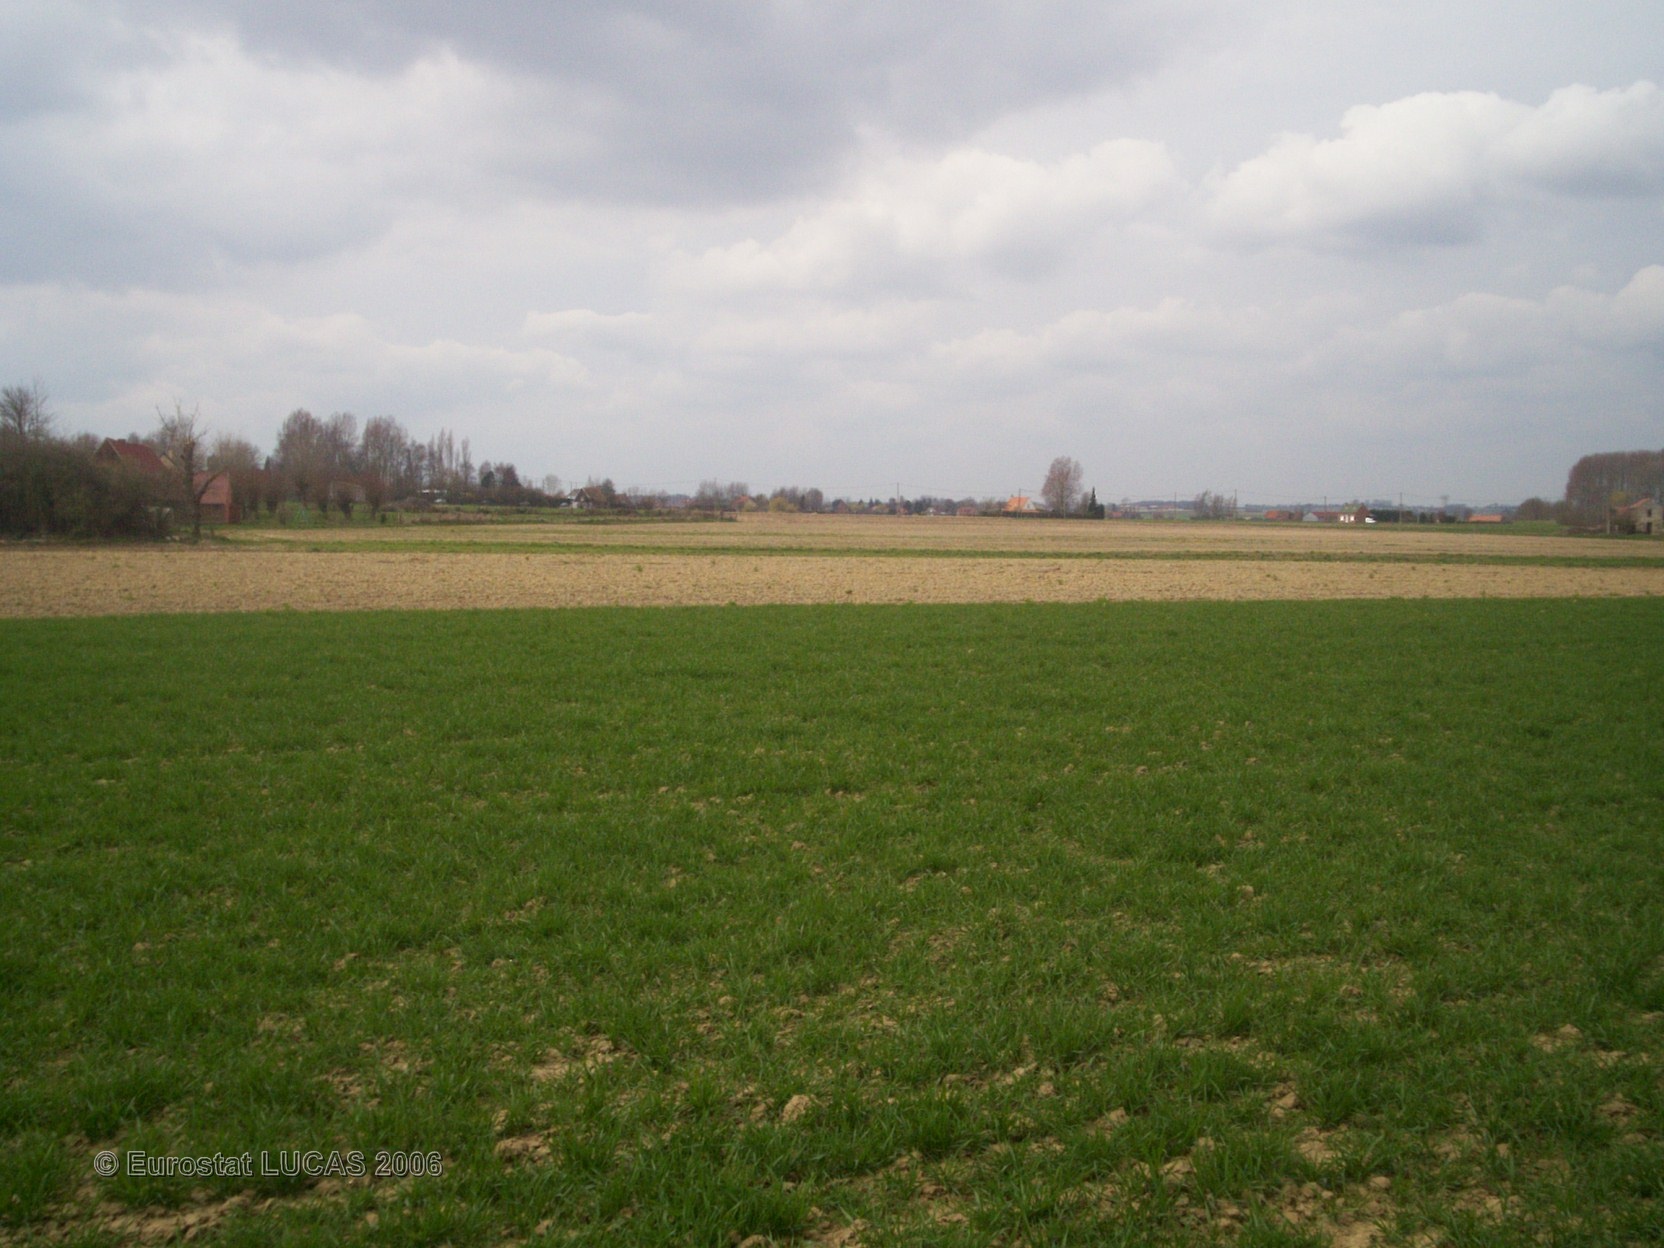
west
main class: Cropland
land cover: Common wheat
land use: Agriculture (excluding fallow land and kitchen gardens)
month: April
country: FR
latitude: 50.7312
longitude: 2.4925
